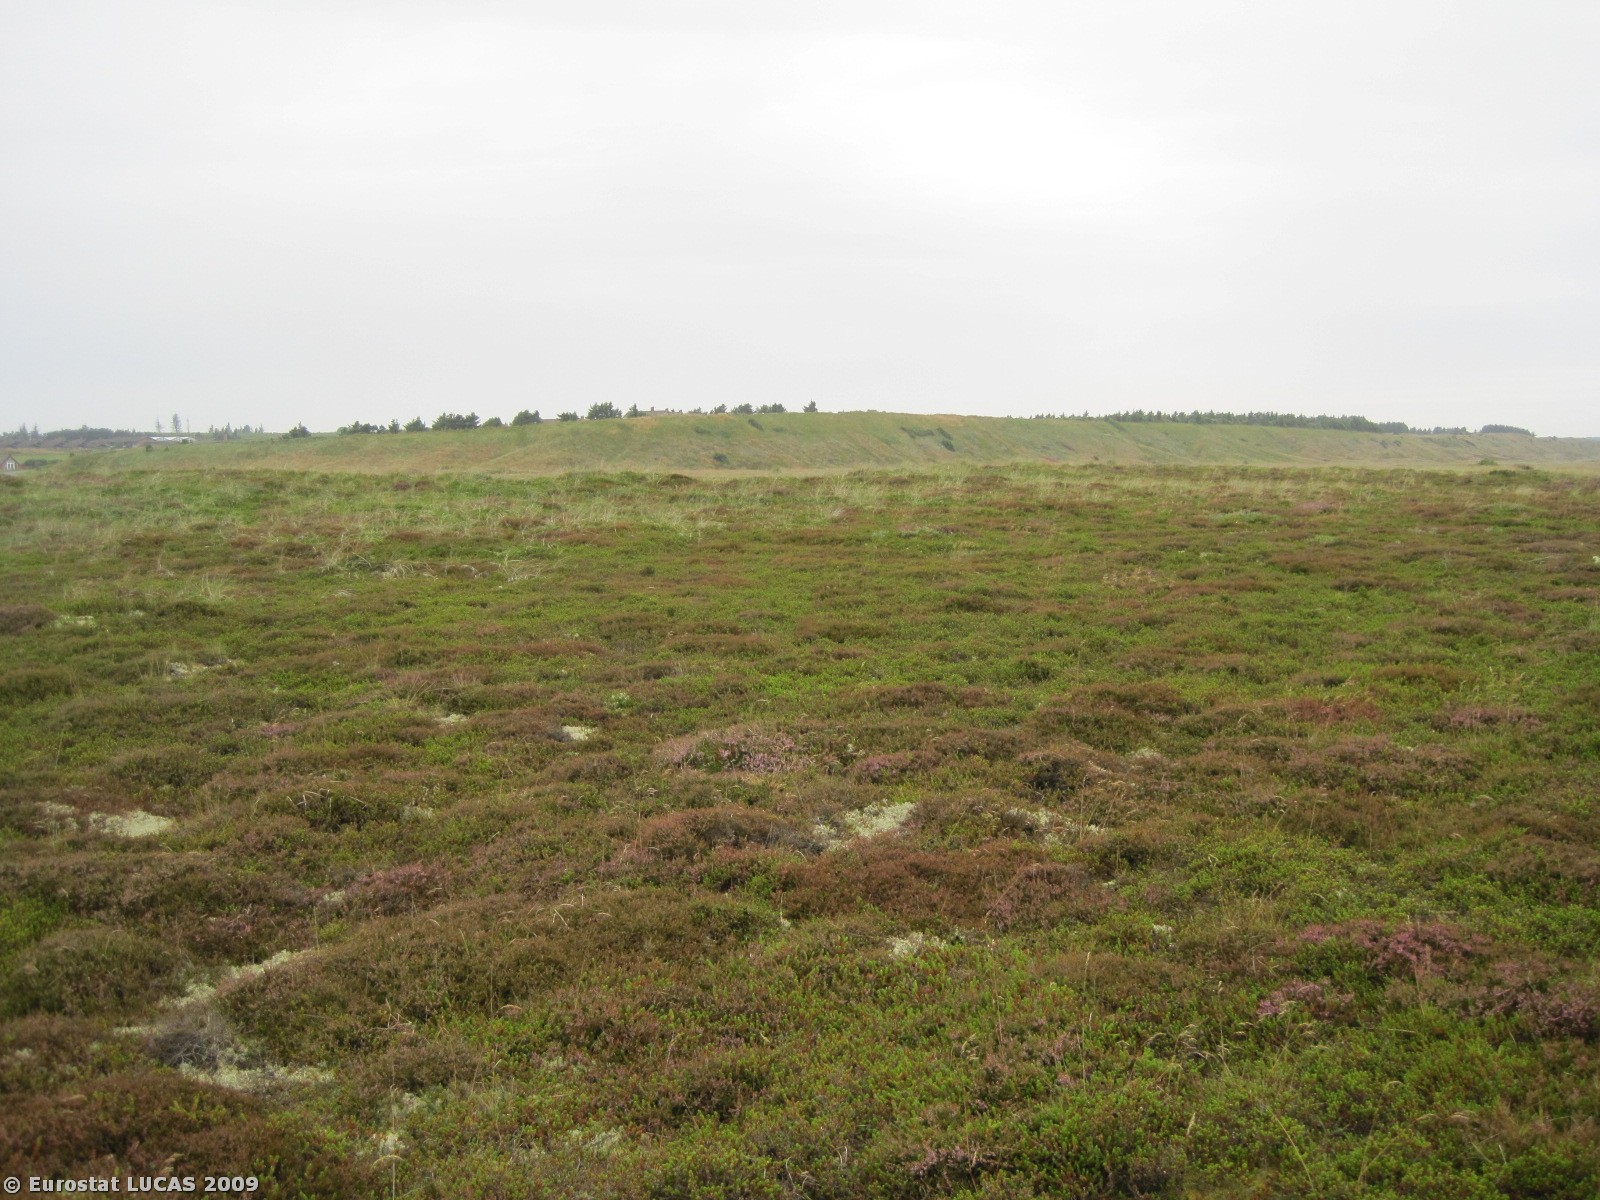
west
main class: Grassland
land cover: Grassland without tree/shrub cover
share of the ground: > 75 %
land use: Nature reserves
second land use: Amenities, museums, leisure
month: July
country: DK
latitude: 57.0984
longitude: 8.7309
